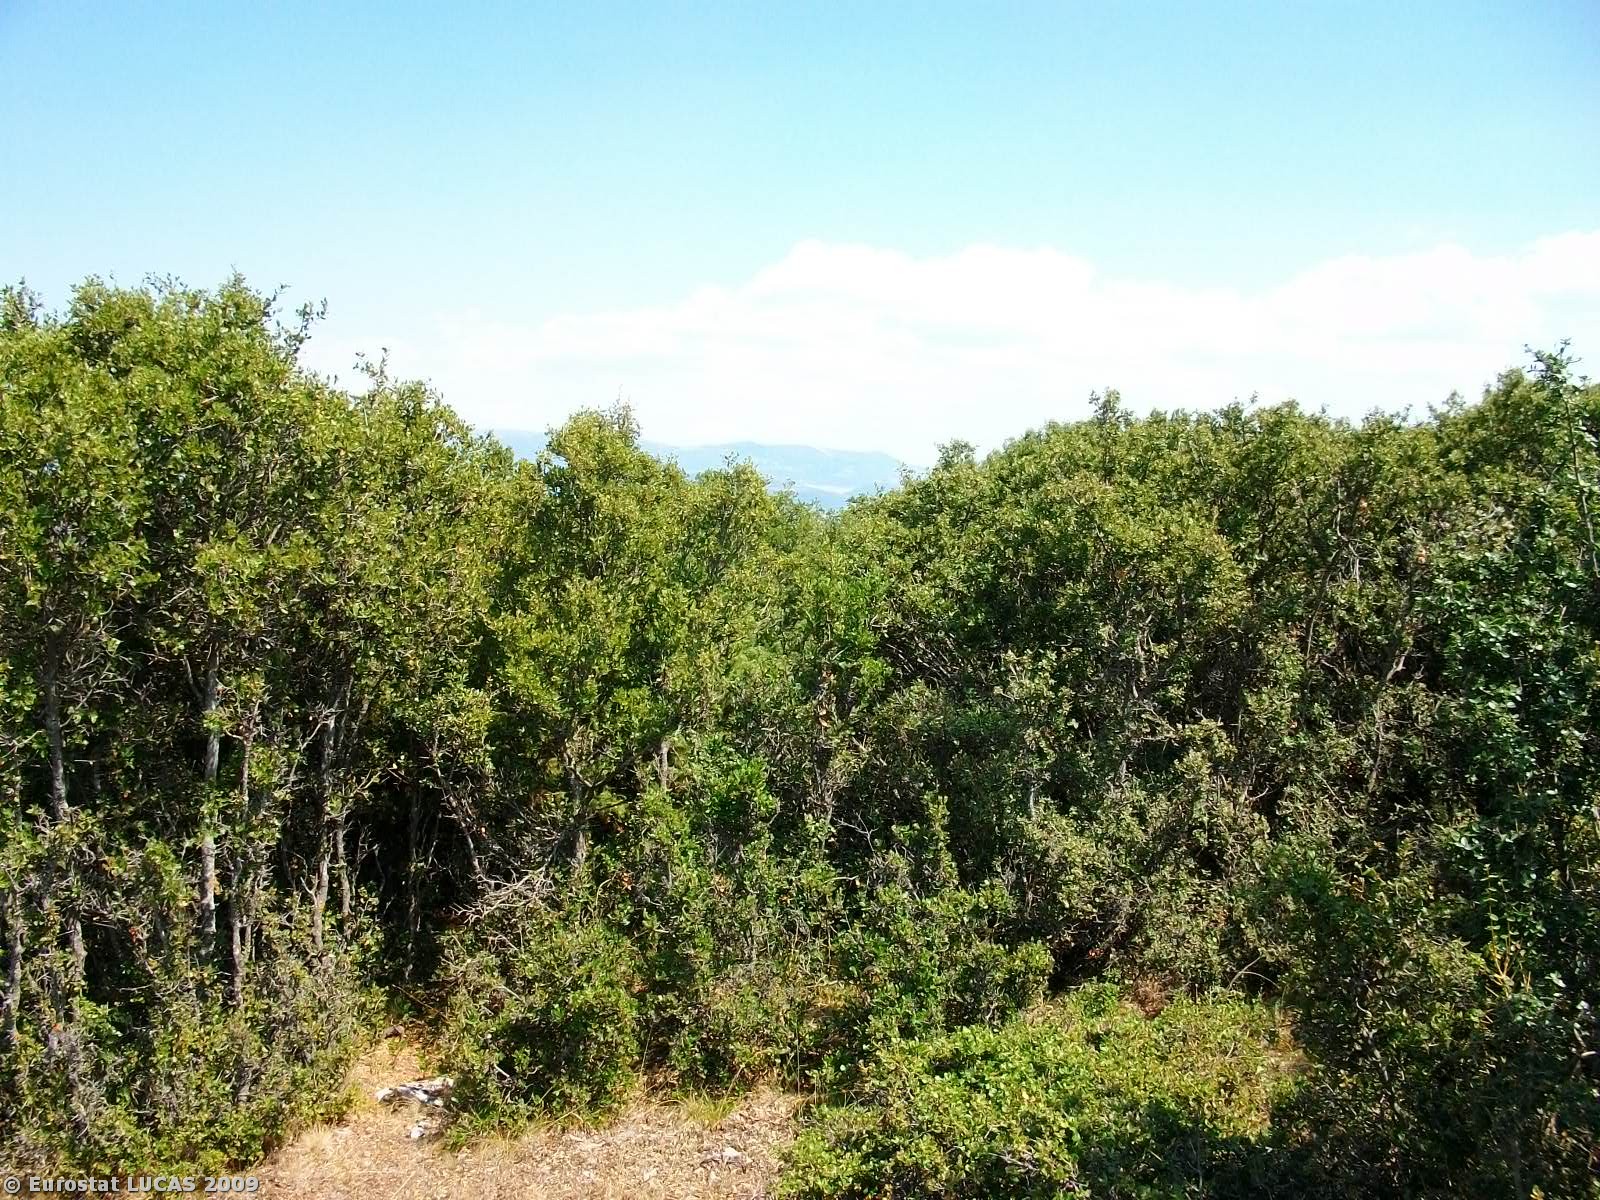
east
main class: Shrubland
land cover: Shrubland without tree cover
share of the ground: > 75 %
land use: Unused
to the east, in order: Shrubland without tree cover; Grassland without tree/shrub cover; Broadleaved woodland; Grassland without tree/shrub cover; Paved roads, cycling and walking lanes; Grassland without tree/shrub cover; Tracks
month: July
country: GR
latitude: 40.1566
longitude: 21.7891
